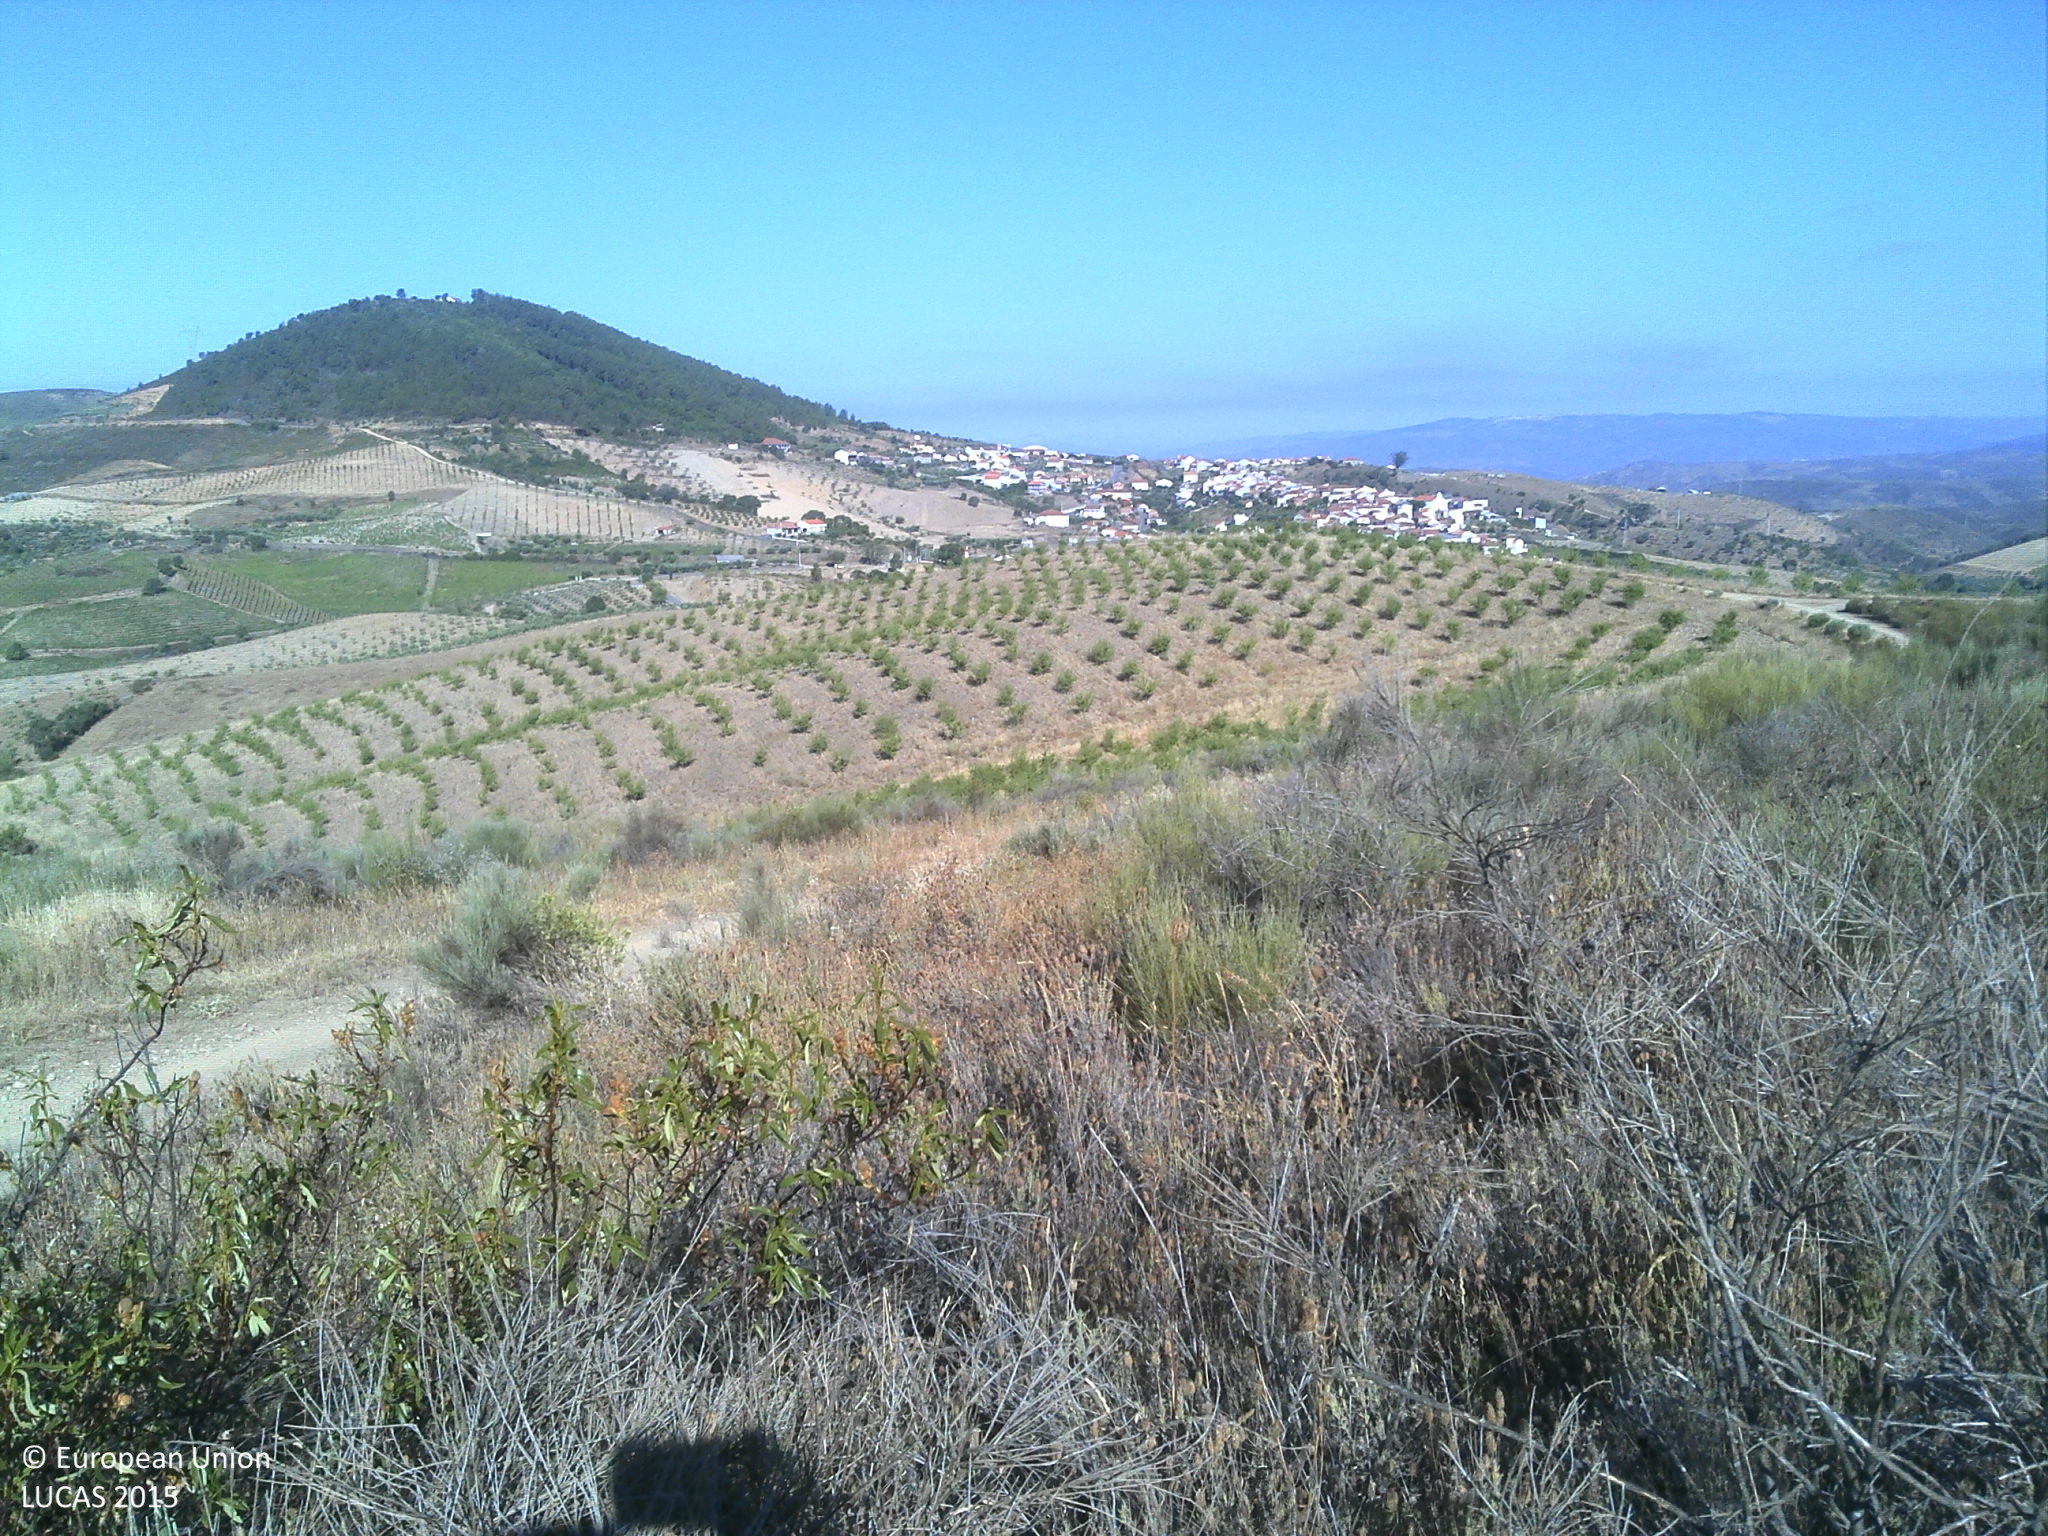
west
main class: Shrubland
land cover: Shrubland without tree cover
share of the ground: > 75 %
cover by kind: shrubs 100 %
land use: Semi-natural and natural areas not in use
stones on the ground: 25 - 50 %
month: July
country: PT
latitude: 41.0841
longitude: -6.9506
